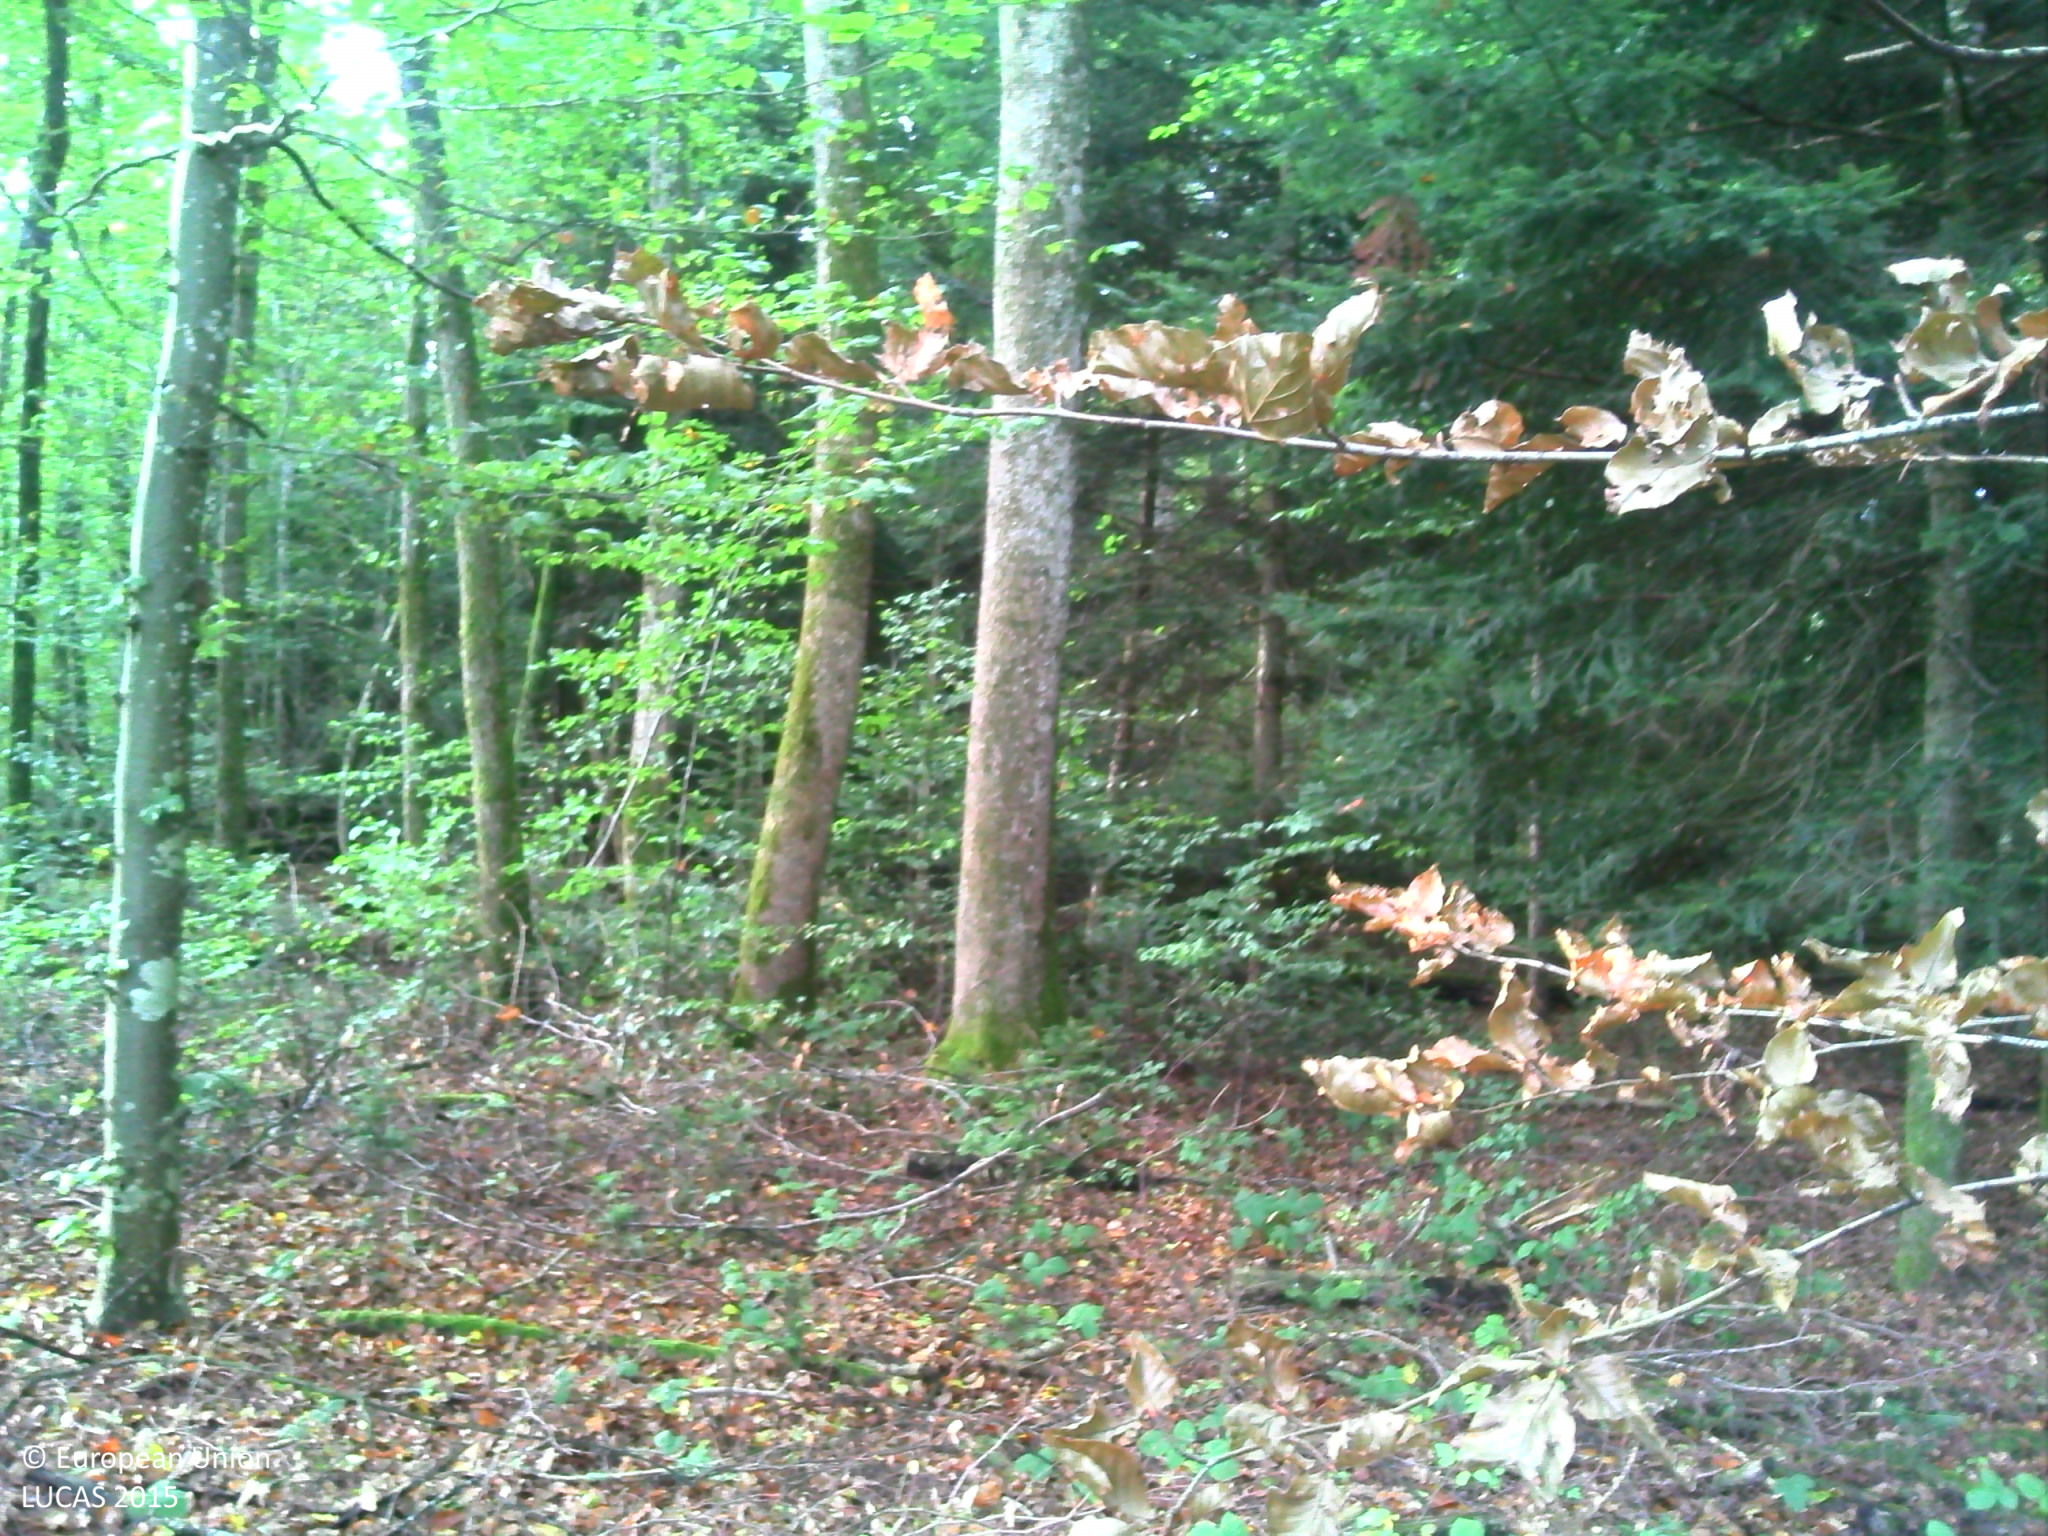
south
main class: Woodland
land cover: Other mixed woodland
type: hemiboreal forest and nemoral coniferous forest and mixed broadleaved-coniferous forest
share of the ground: > 75 %
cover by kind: broadleaved forest trees 45 %, coniferous forest trees 40 %, consolidated bare surface 10 %, herbaceous plants 5 %
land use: Forestry
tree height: > 5 m
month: September
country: FR
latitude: 48.4659
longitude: 6.8224
